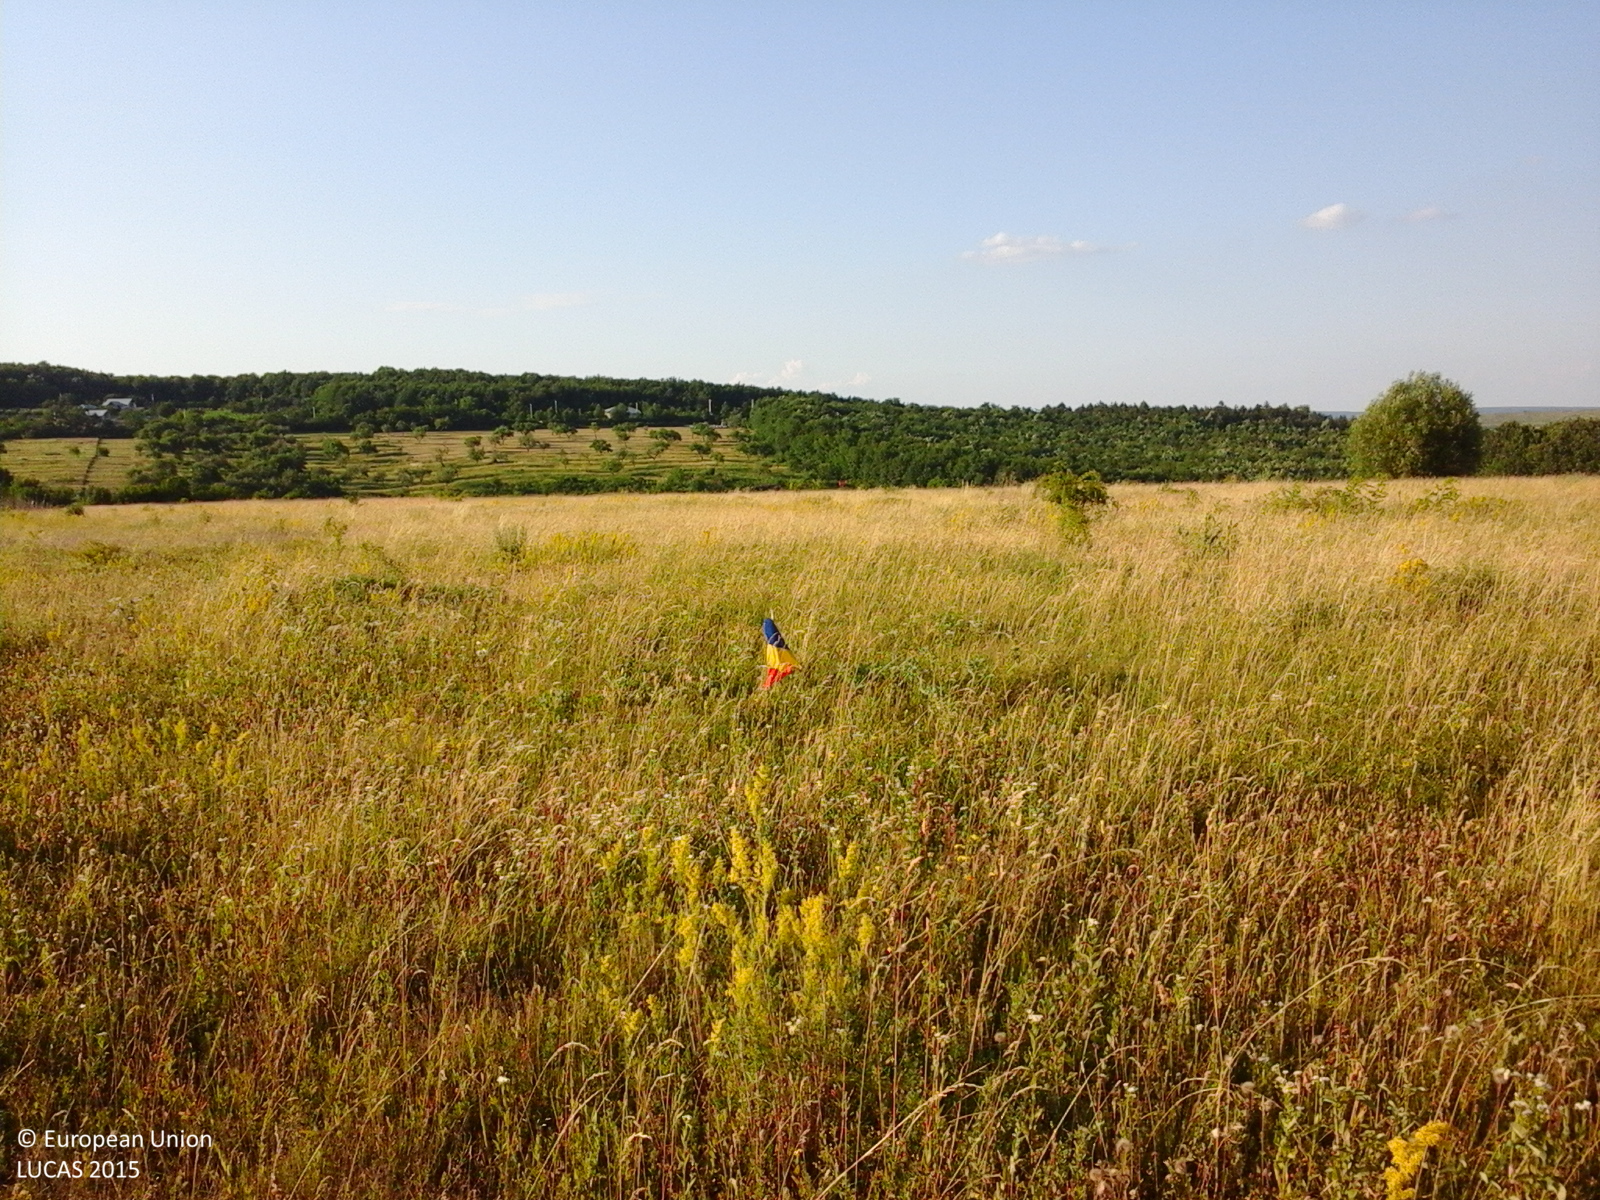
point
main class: Grassland
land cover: Grassland without tree/shrub cover
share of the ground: > 75 %
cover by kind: herbaceous plants 100 %
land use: Agriculture (excluding fallow land and kitchen gardens)
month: June
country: RO
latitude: 47.5951
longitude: 26.8429
